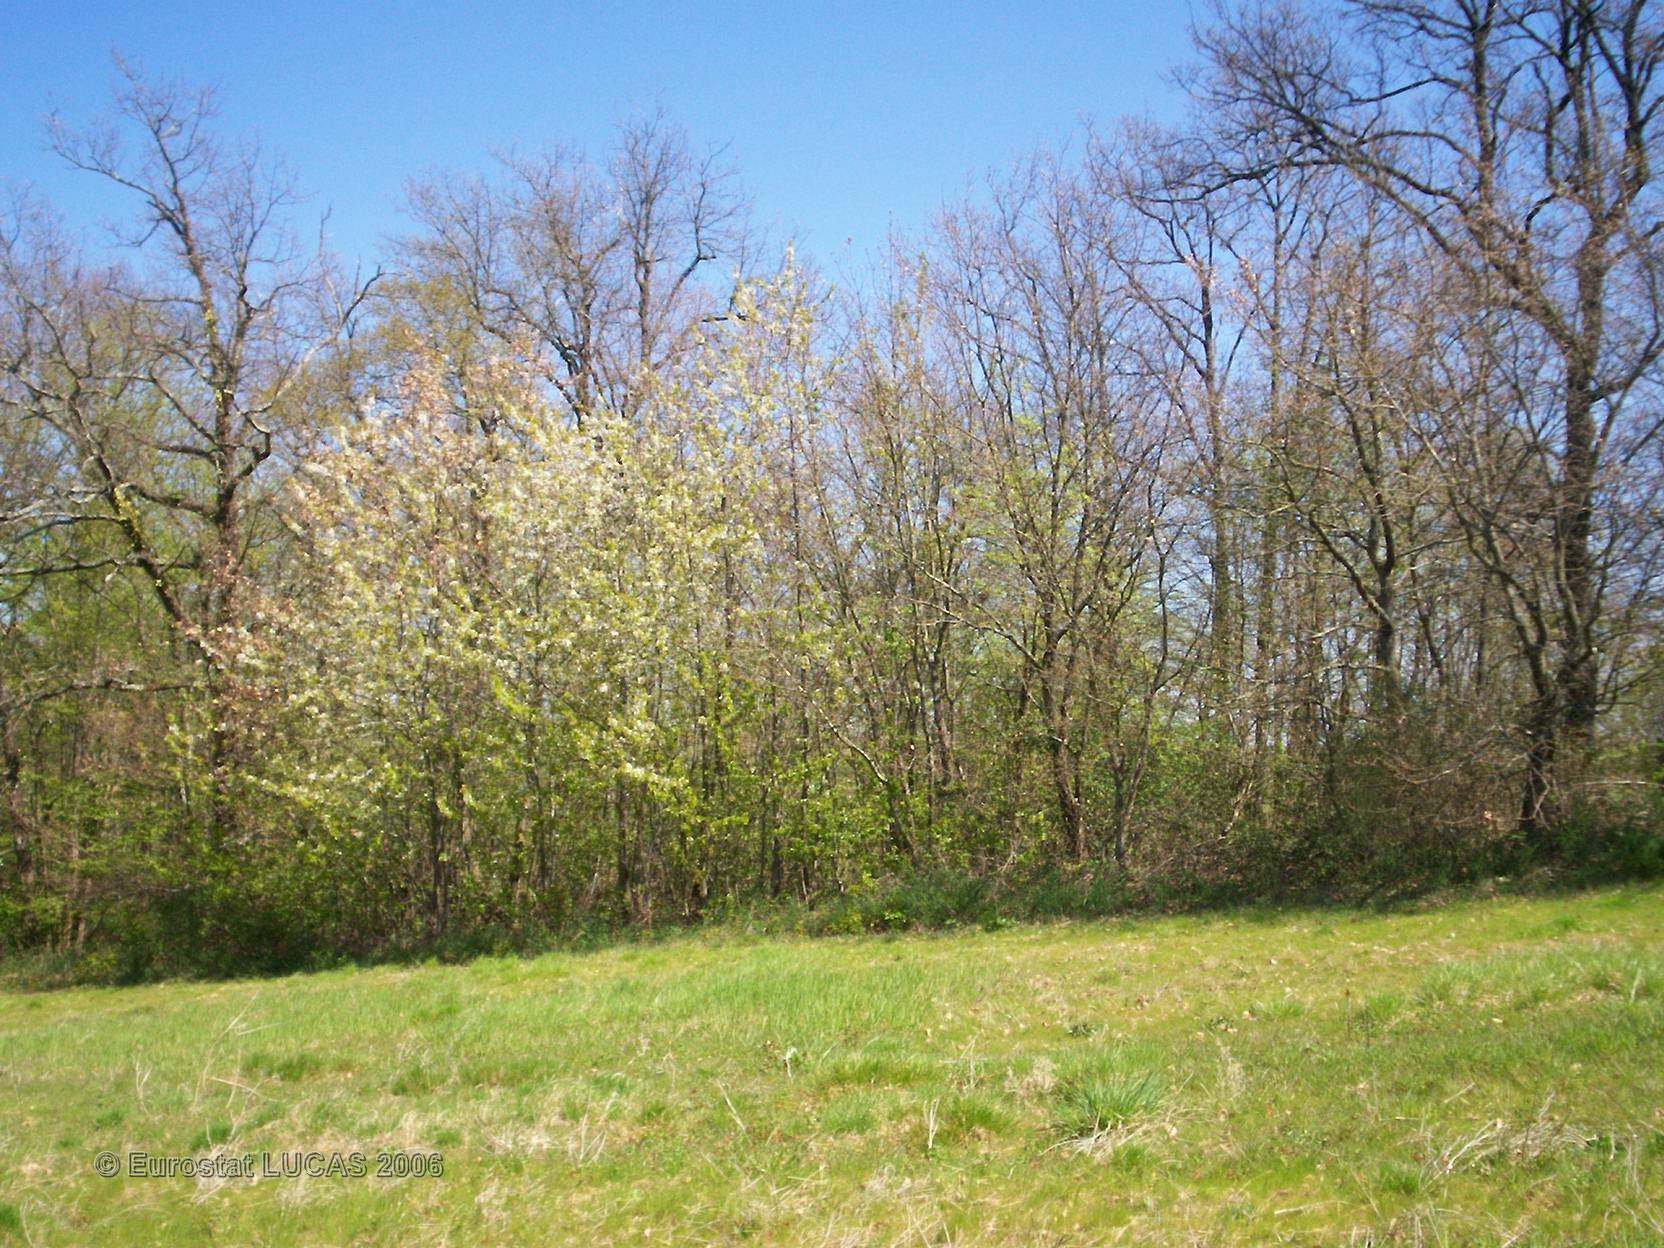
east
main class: Grassland
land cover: Grassland without tree/shrub cover
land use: Agriculture (excluding fallow land and kitchen gardens)
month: April
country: FR
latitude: 43.8618
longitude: 0.9282
